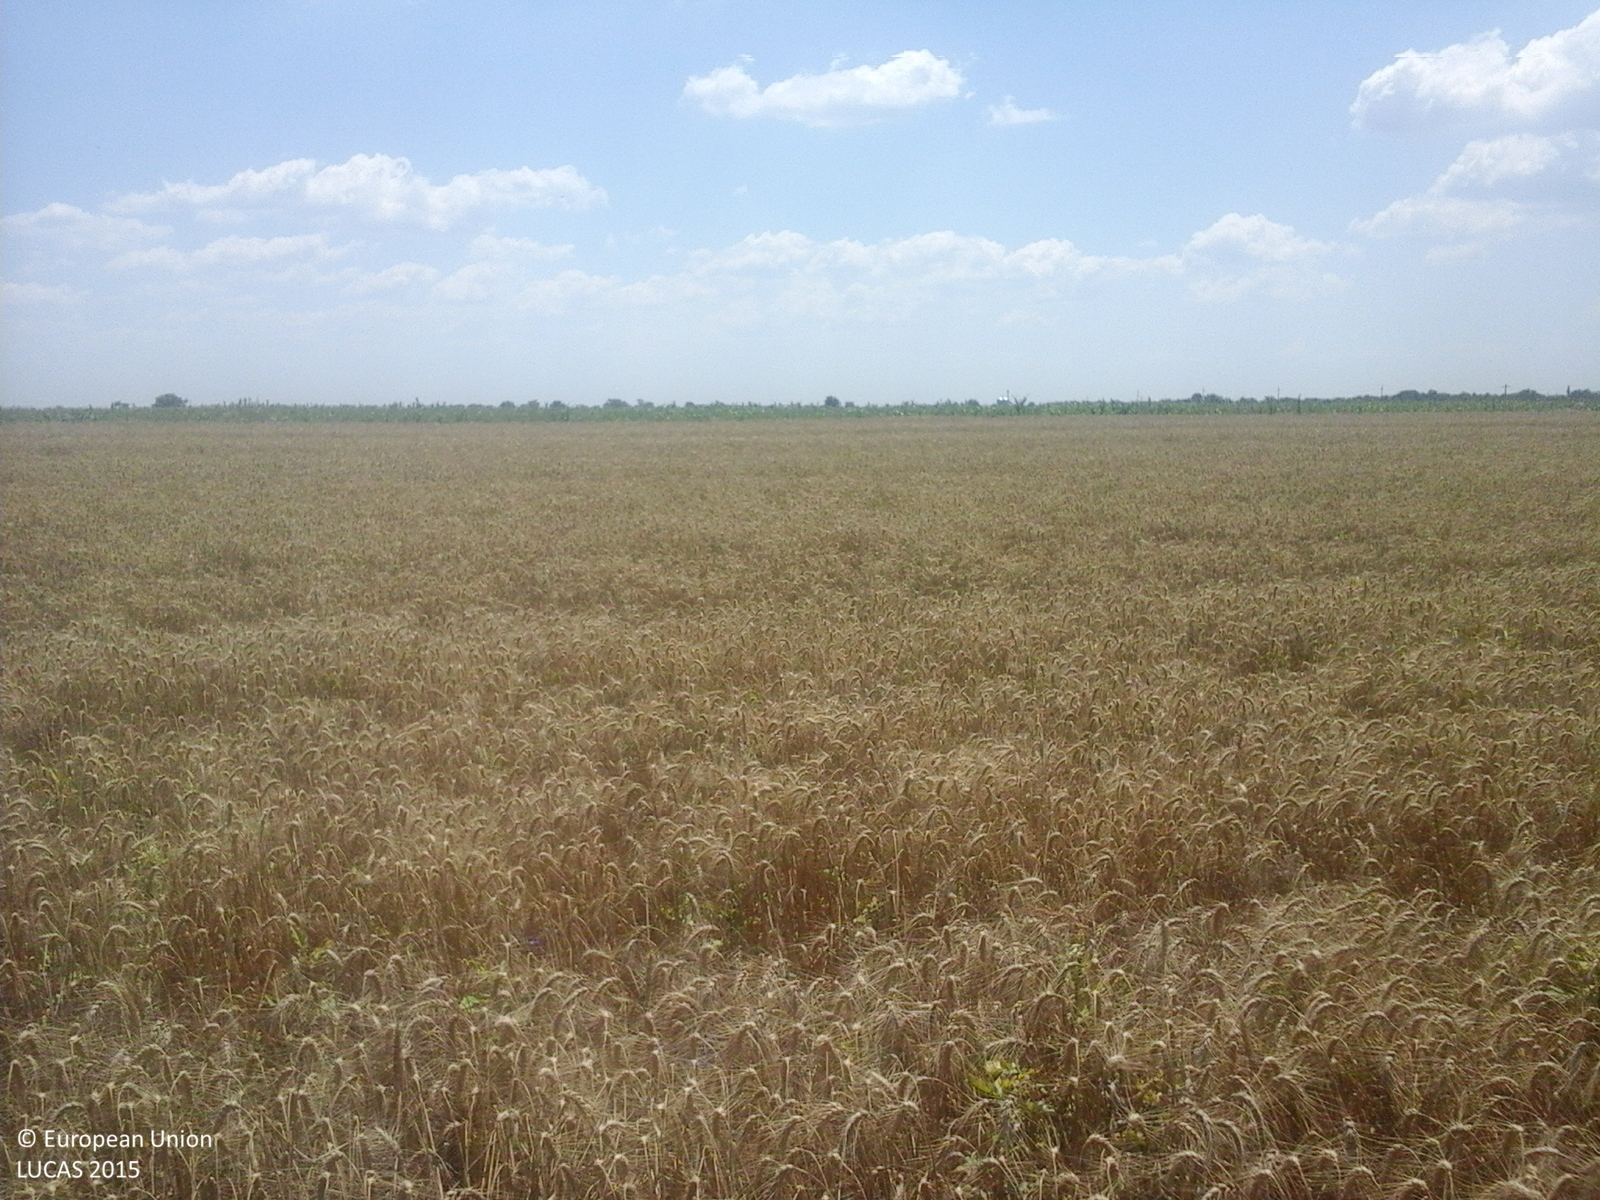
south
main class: Cropland
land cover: Common wheat
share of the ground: > 75 %
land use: Agriculture (excluding fallow land and kitchen gardens)
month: July
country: RO
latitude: 44.1660
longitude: 24.7675
